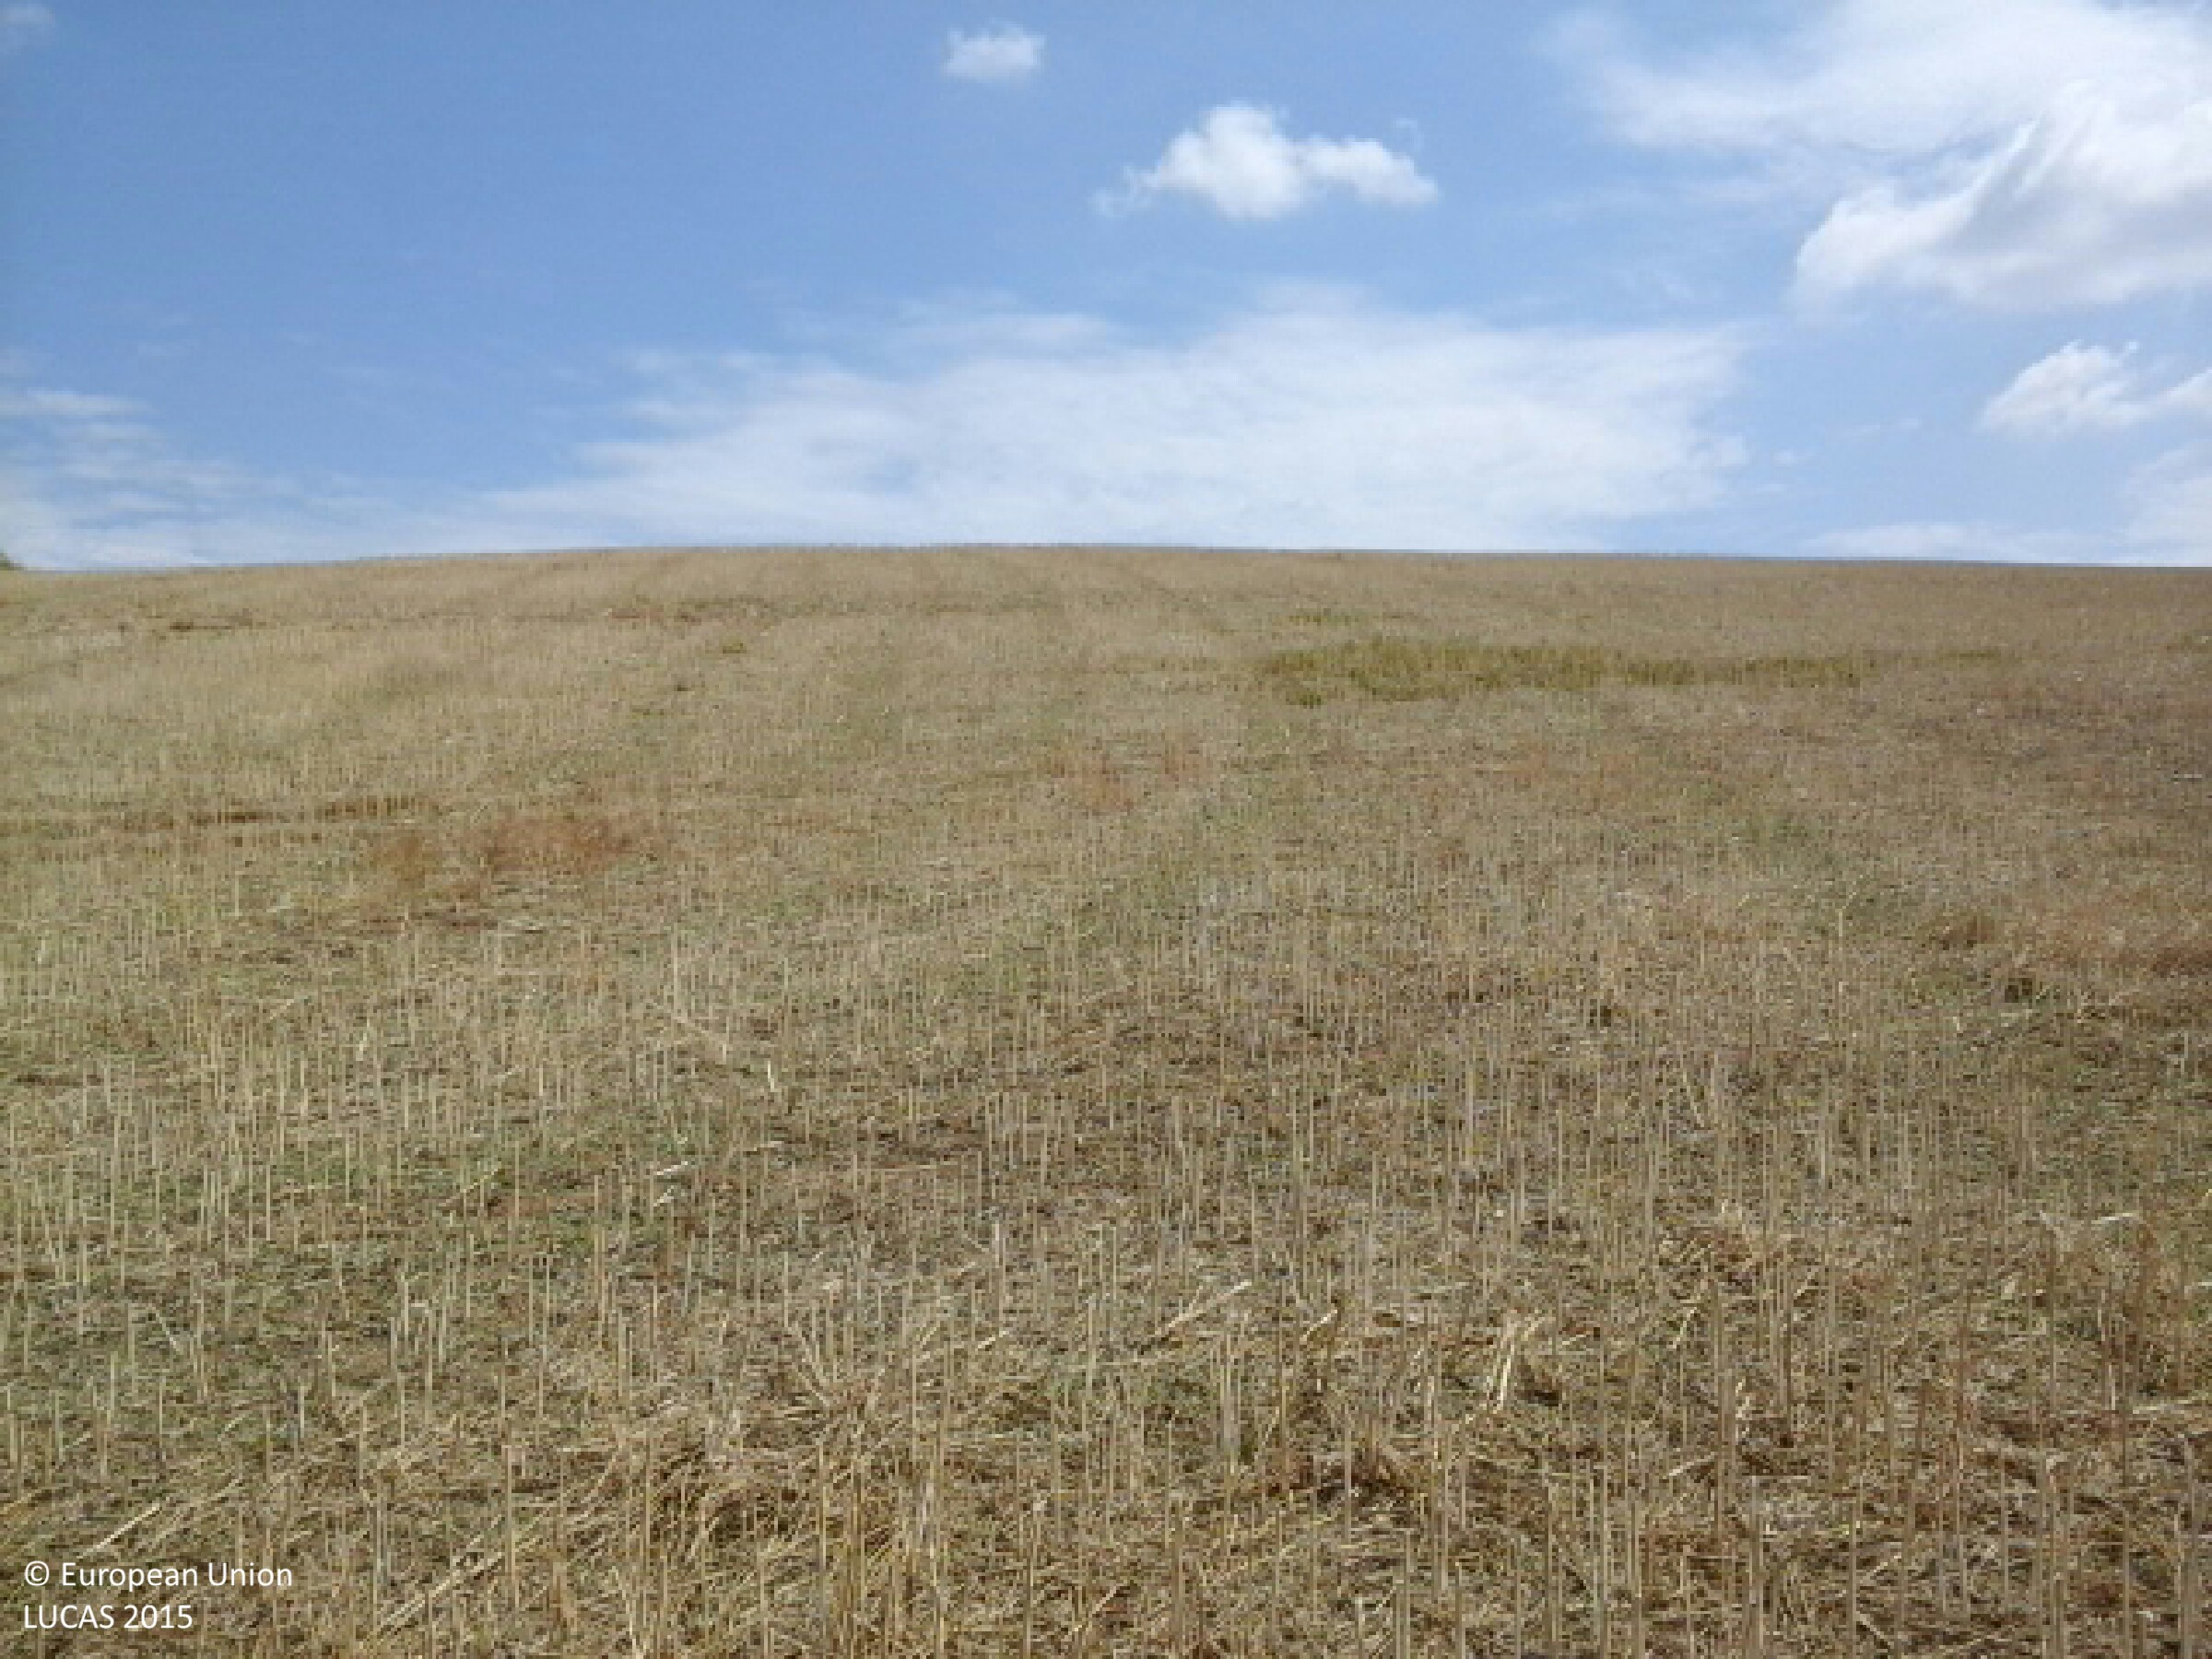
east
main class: Cropland
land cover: Rape and turnip rape
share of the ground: 10 - 25 %
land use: Agriculture (excluding fallow land and kitchen gardens)
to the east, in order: Rape and turnip rape
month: August
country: HU
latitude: 47.5822
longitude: 18.5638
